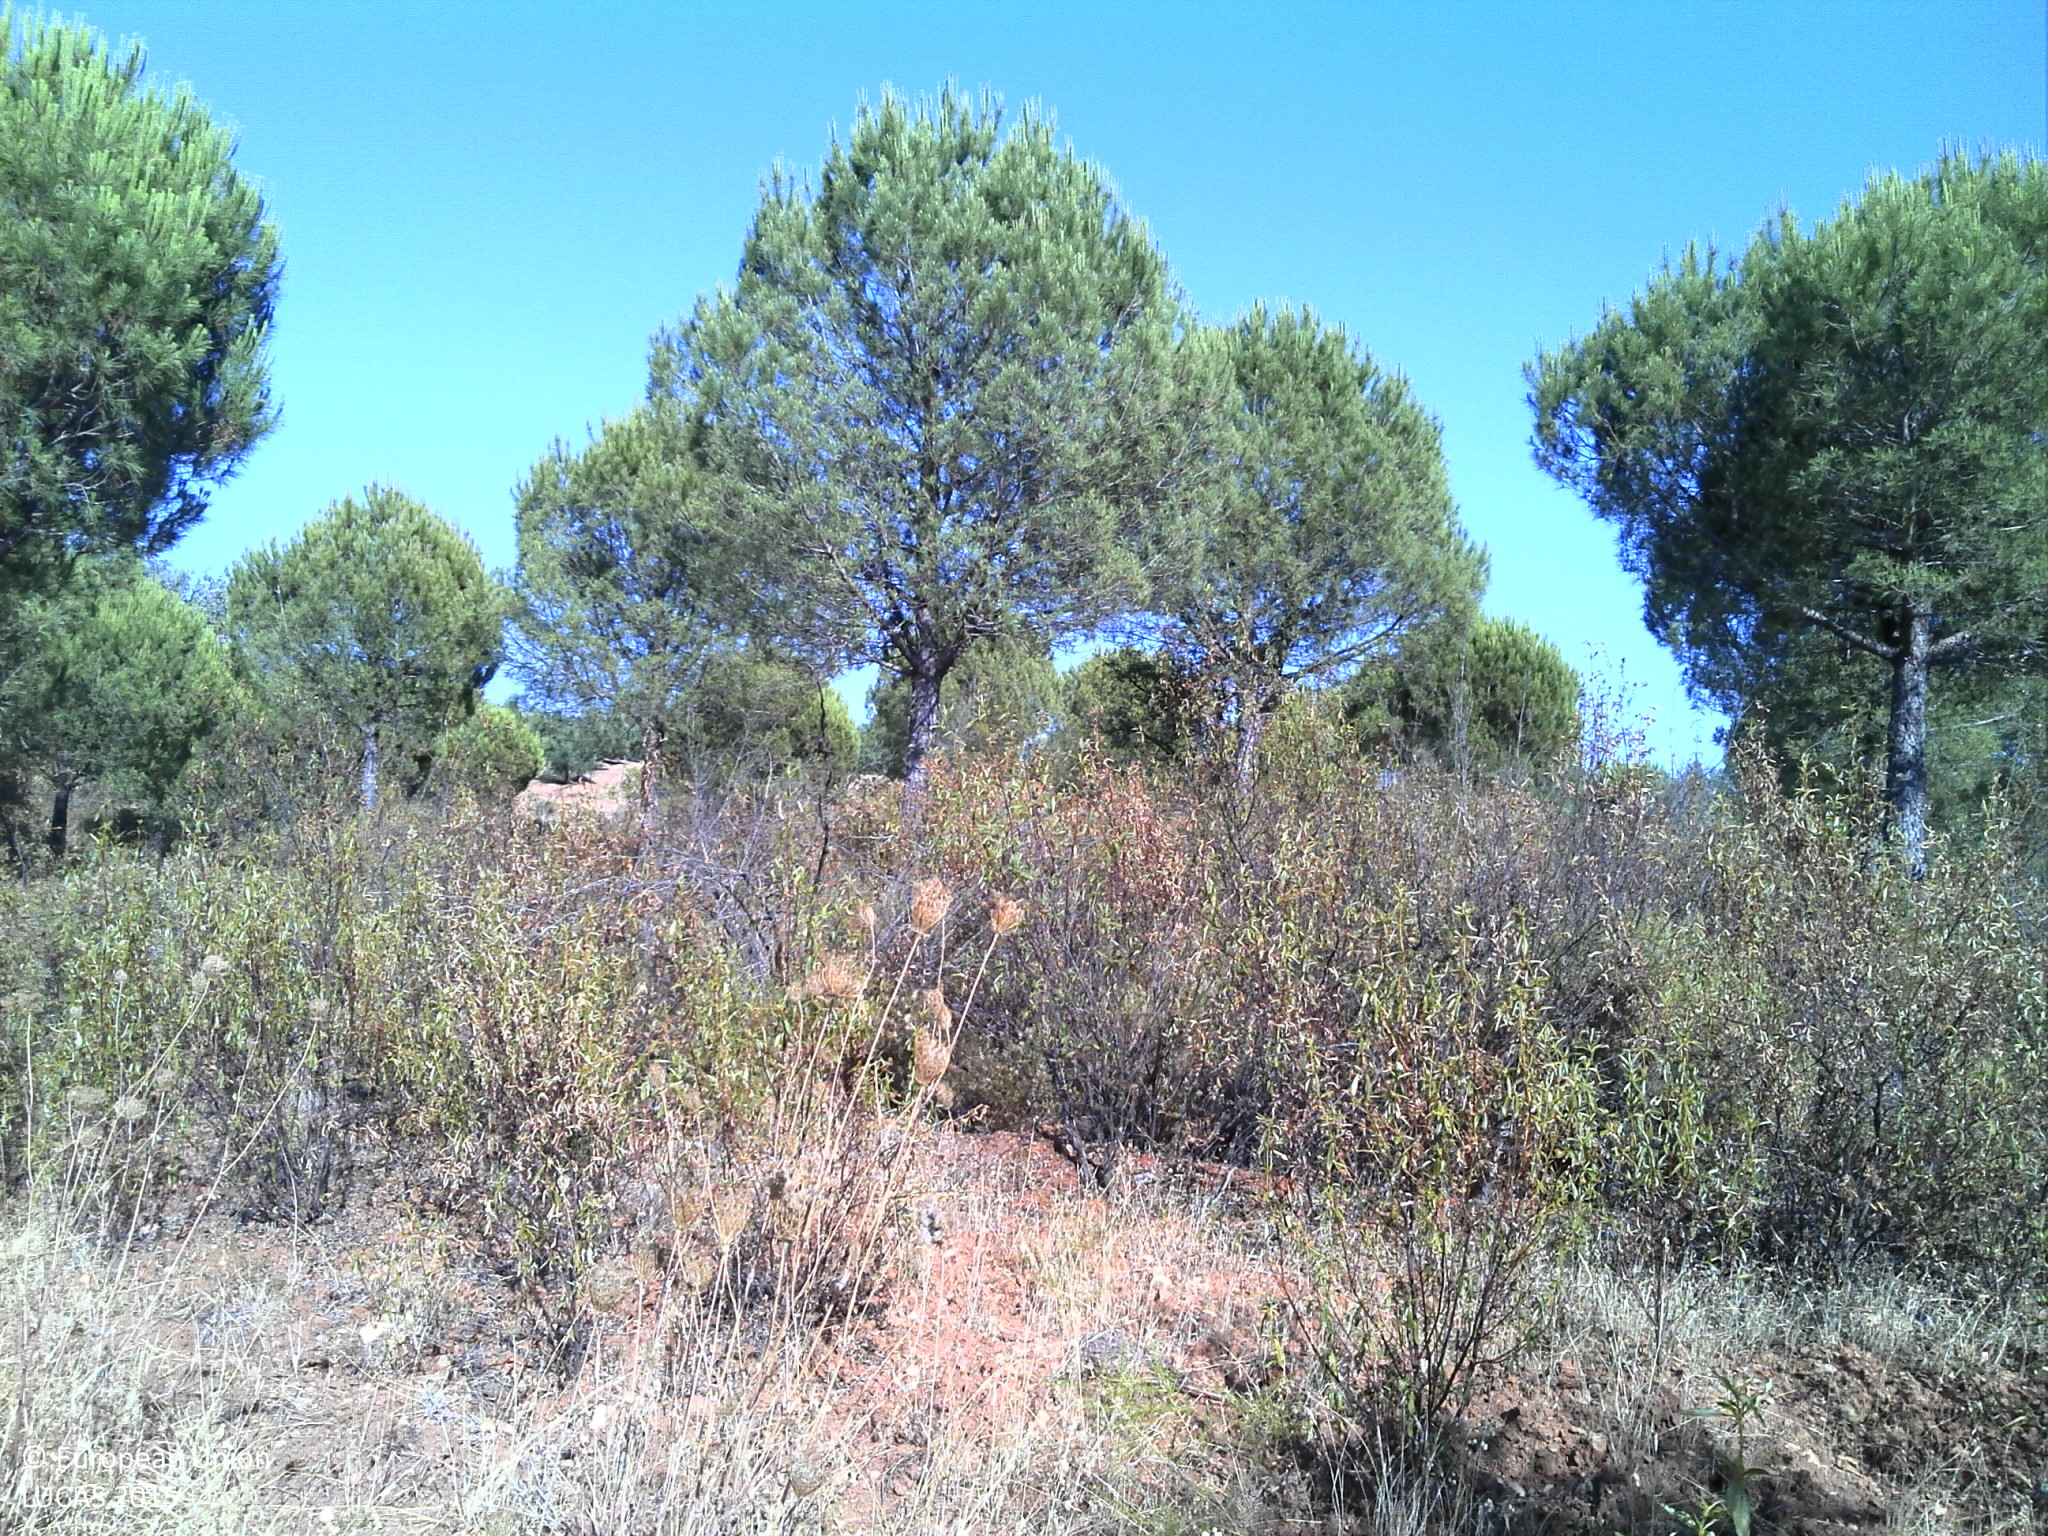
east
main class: Woodland
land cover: Pine dominated coniferous woodland
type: coniferous forest of the mediterranean region
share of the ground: 25 - 50 %
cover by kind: shrubs 50 %, coniferous forest trees 30 %, unconsolidated bare surface 15 %, herbaceous plants 5 %
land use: Forestry
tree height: > 5 m
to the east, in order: Pine dominated coniferous woodland; Tracks; Olive groves; Tracks; Broadleaved woodland; Fences; Other bare soil; Grassland without tree/shrub cover; Tracks; Grassland without tree/shrub cover
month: July
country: PT
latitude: 38.5615
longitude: -7.7431
